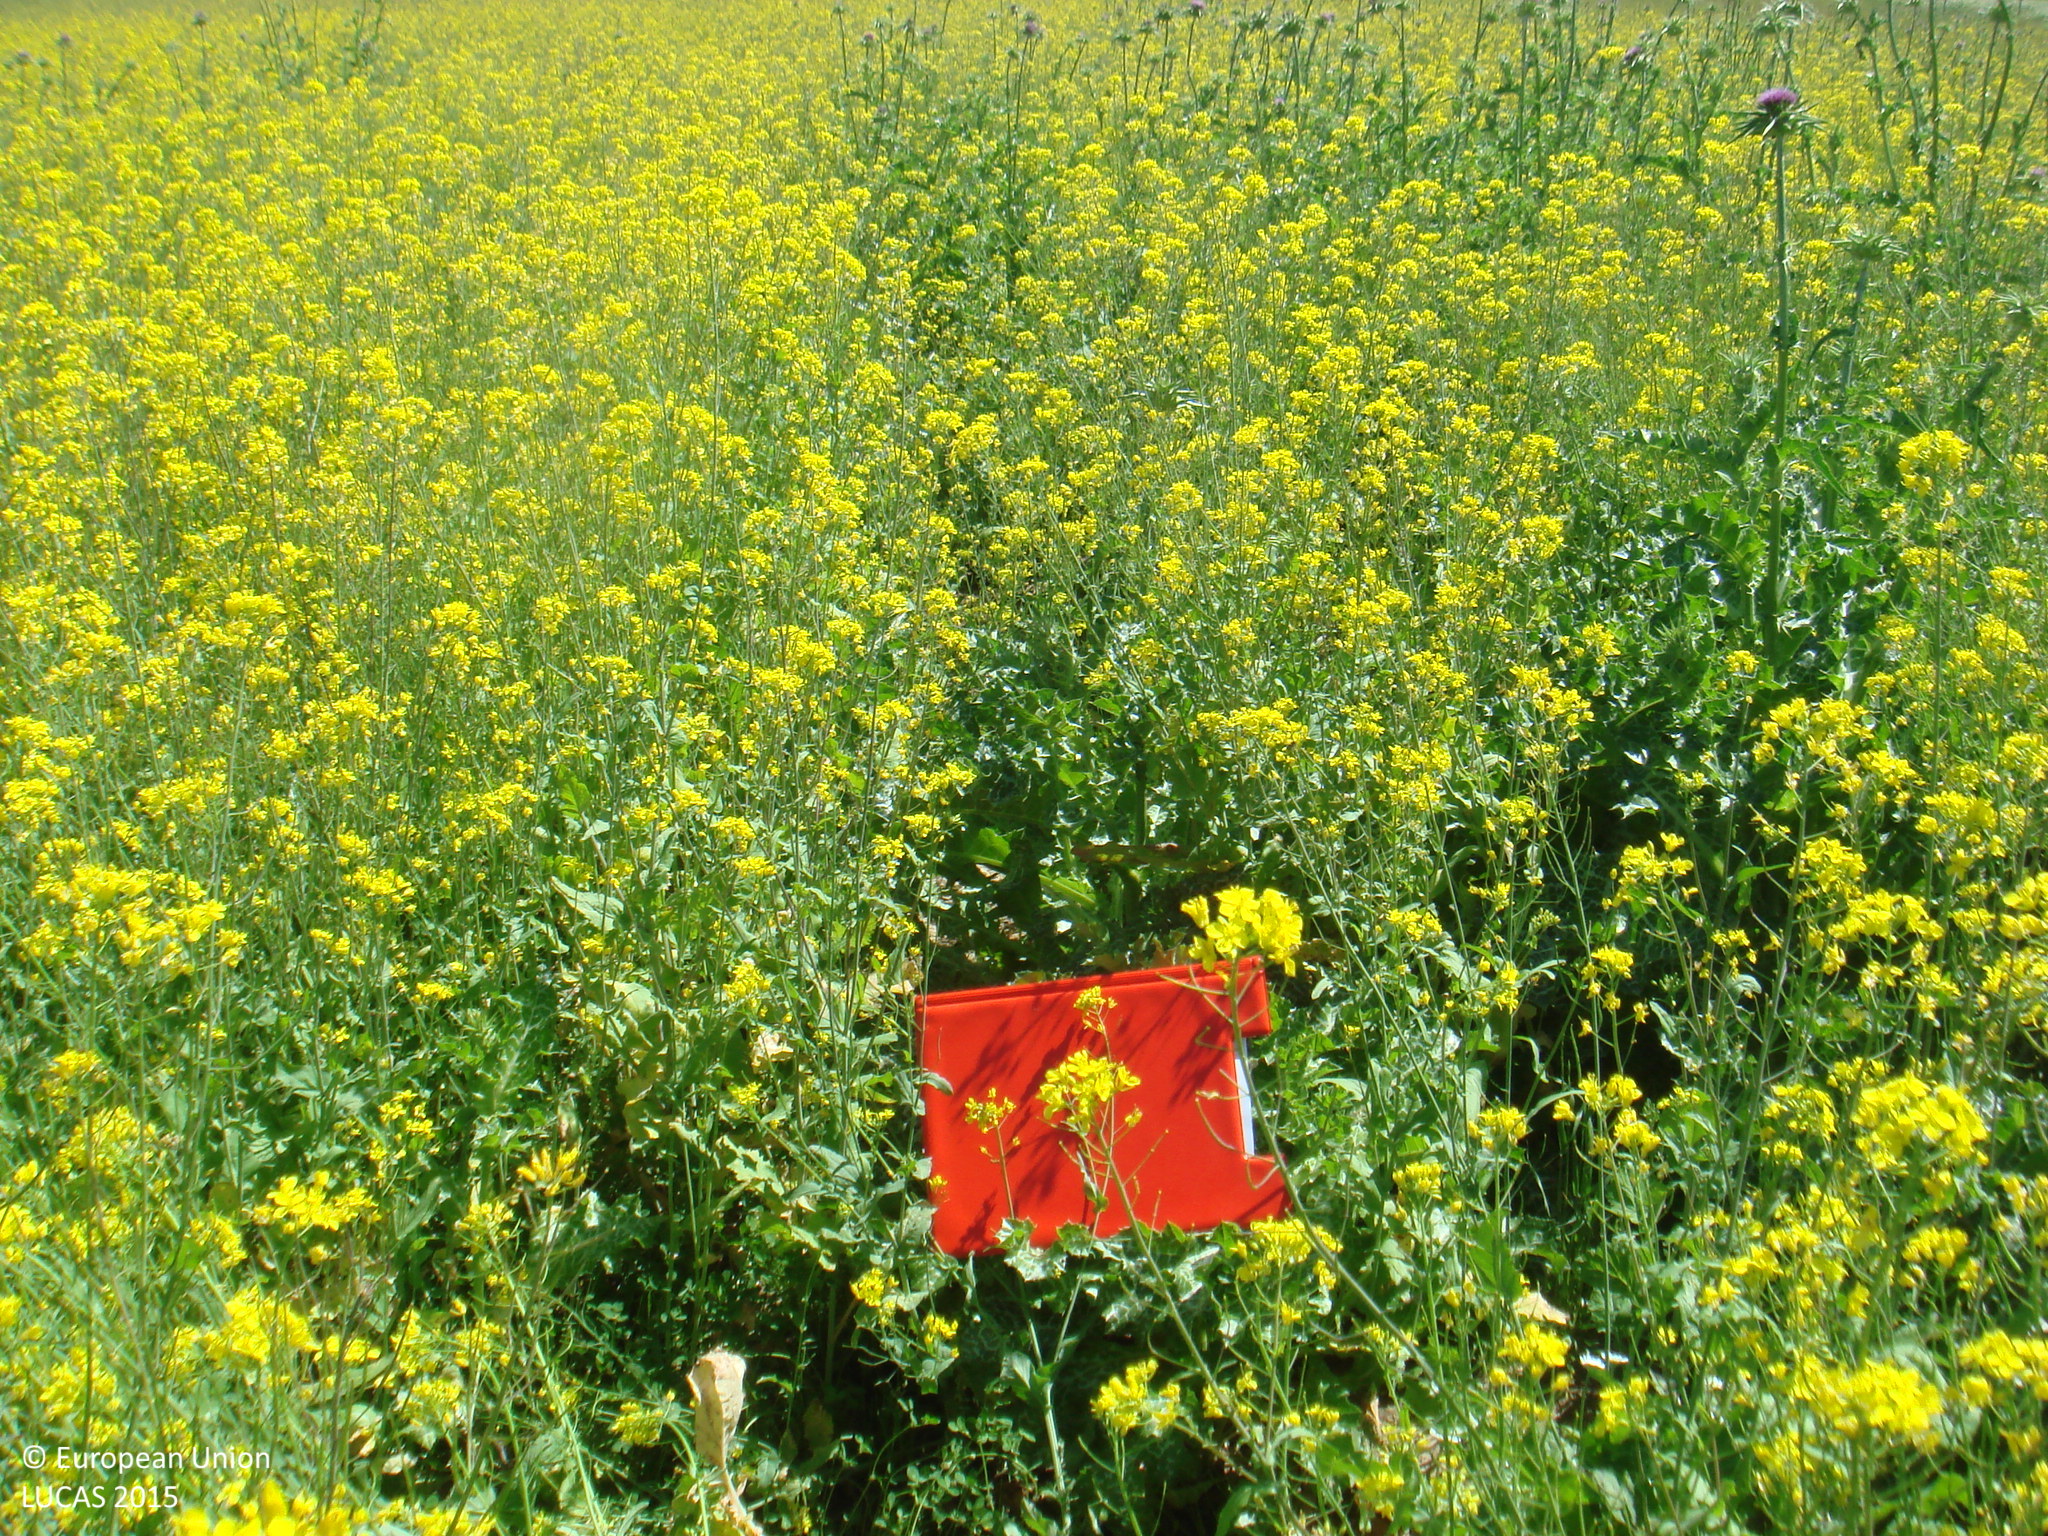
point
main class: Grassland
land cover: Spontaneously vegetated surfaces
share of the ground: > 75 %
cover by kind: herbaceous plants 95 %, shrubs 5 %
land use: Fallow land
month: April
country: ES
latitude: 38.5017
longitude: -5.1079
